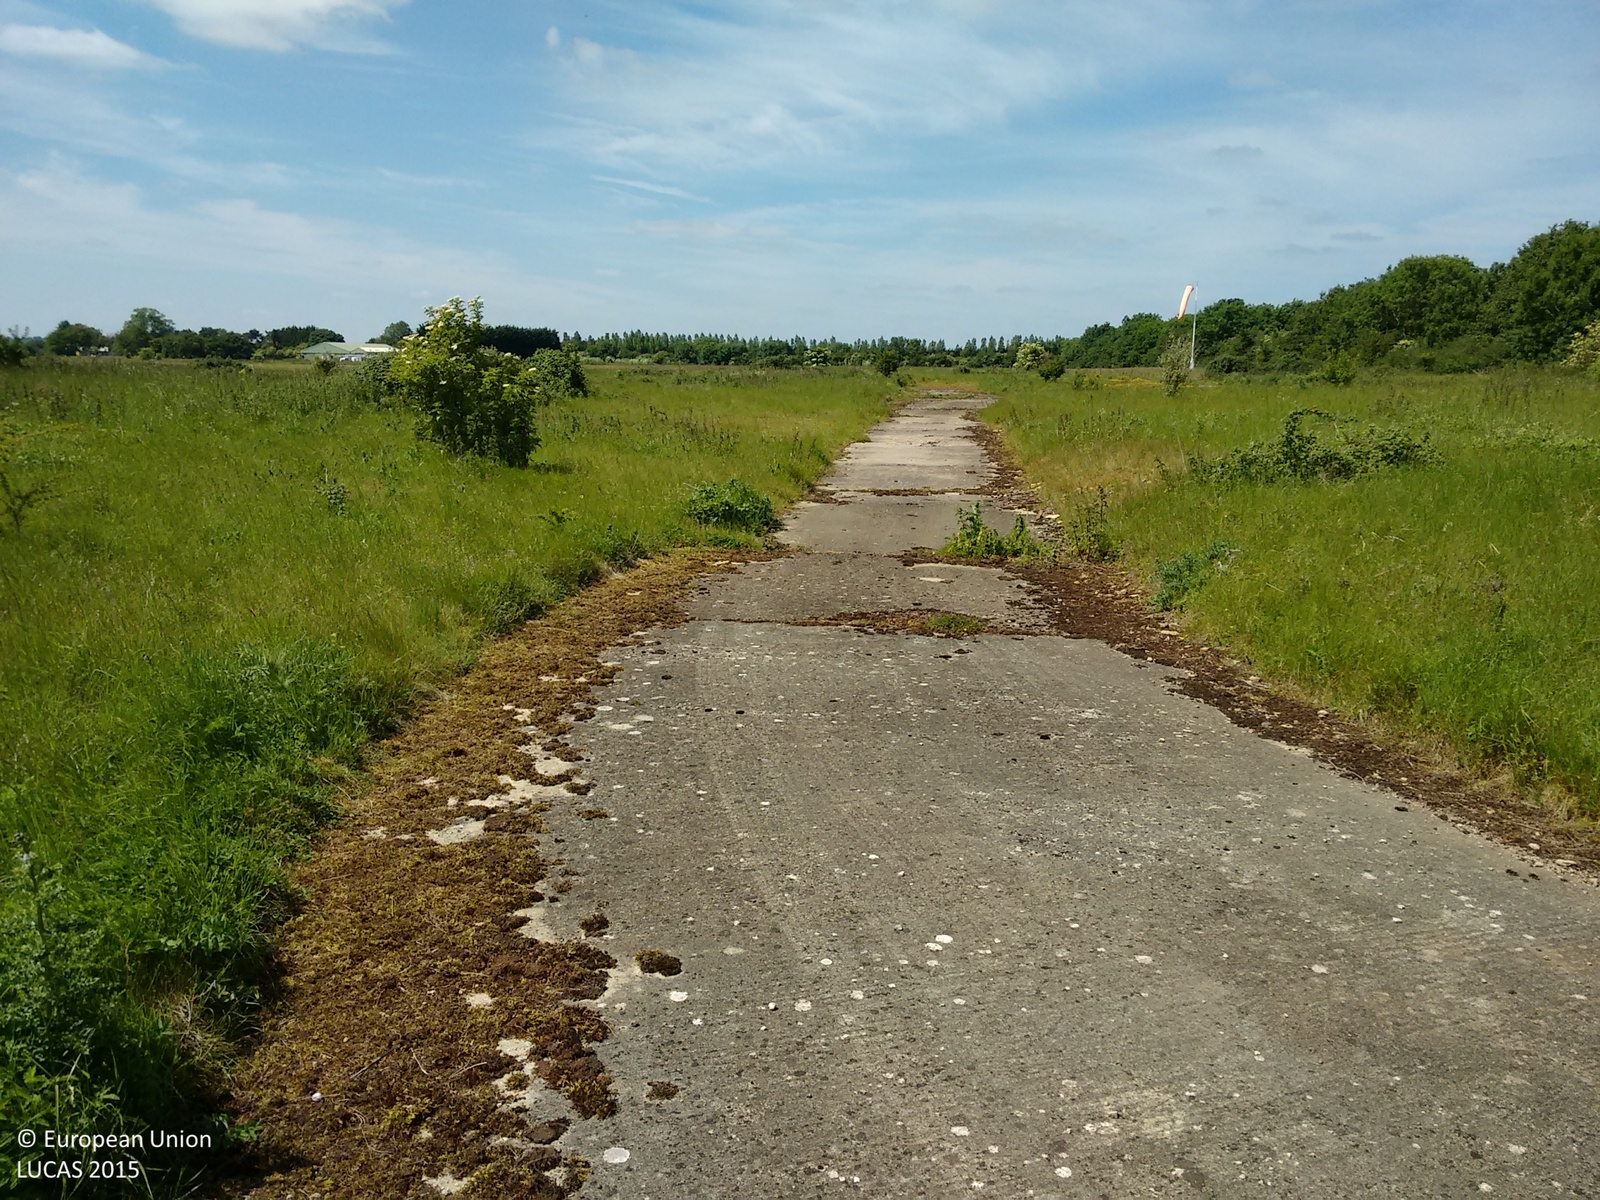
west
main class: Grassland
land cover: Grassland without tree/shrub cover
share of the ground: > 75 %
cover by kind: herbaceous plants 100 %
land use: Air transport
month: June
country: GB
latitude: 51.8801
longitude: -1.2185
